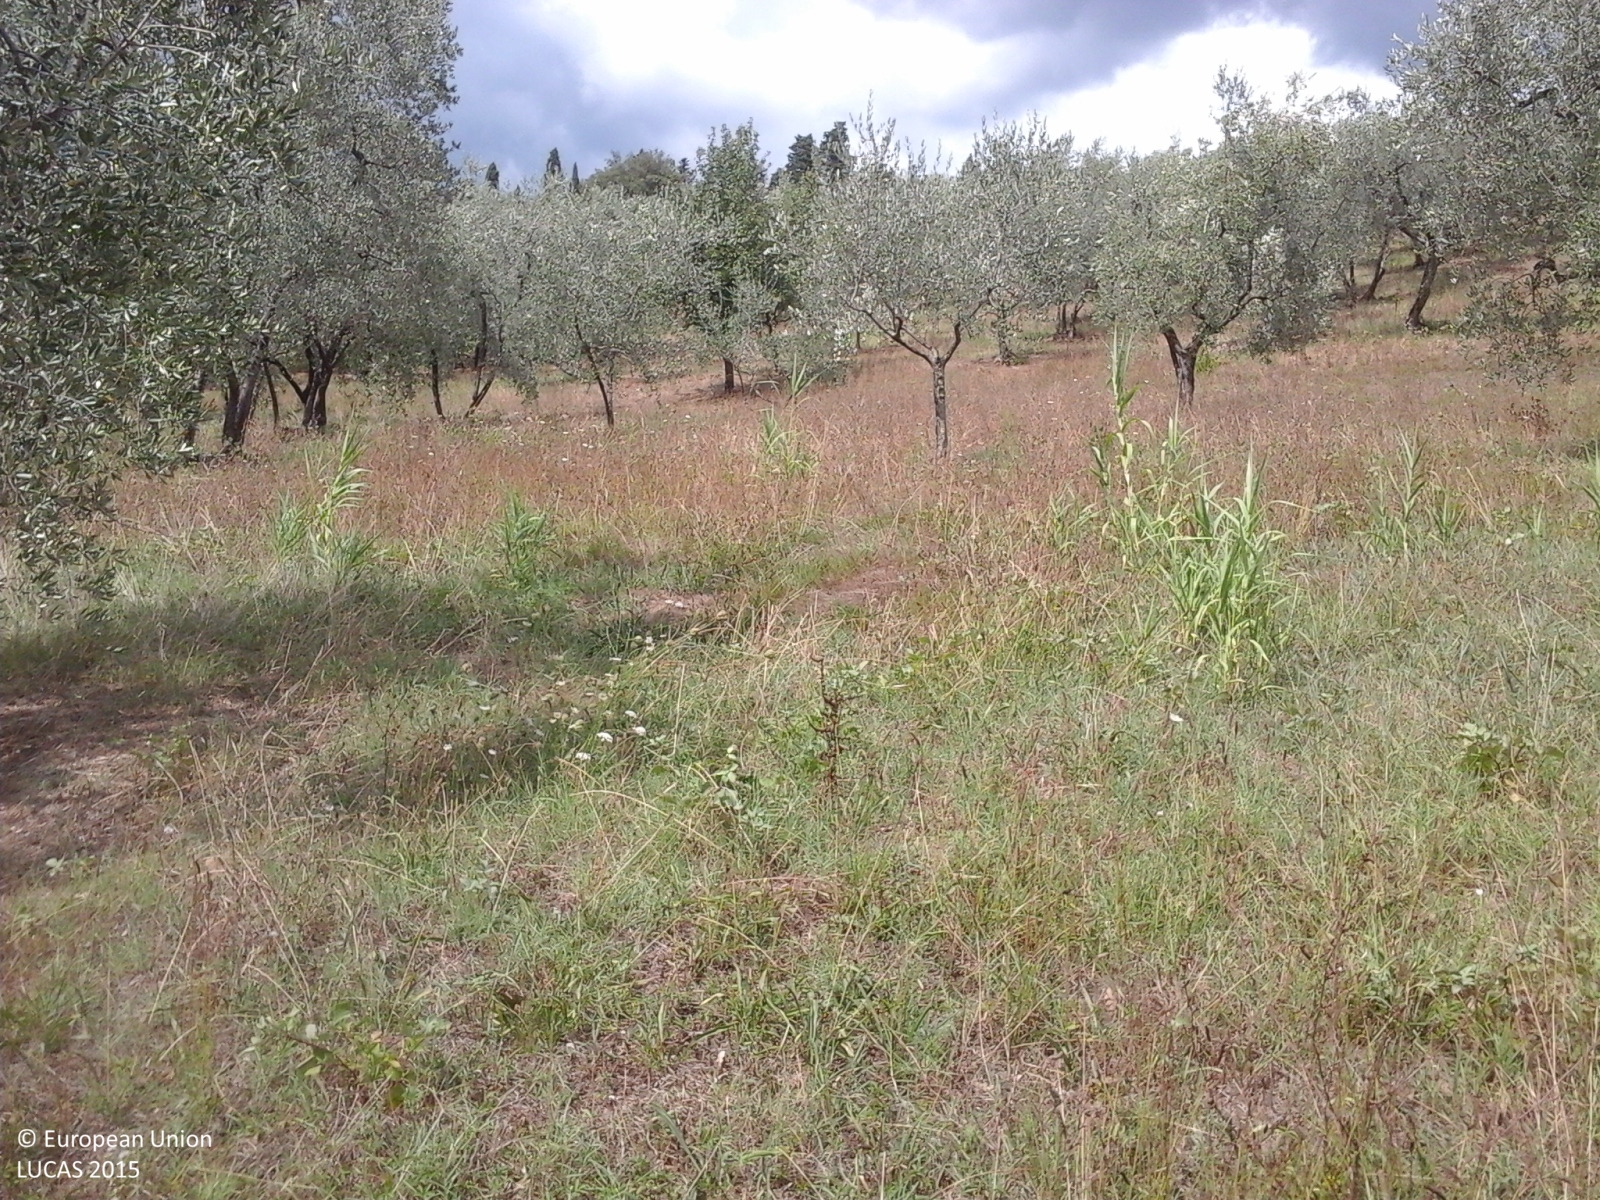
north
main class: Cropland
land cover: Olive groves
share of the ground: > 75 %
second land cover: Grassland without tree/shrub cover
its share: > 75 %
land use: Agriculture (excluding fallow land and kitchen gardens)
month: August
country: IT
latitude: 43.8778
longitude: 10.8813
